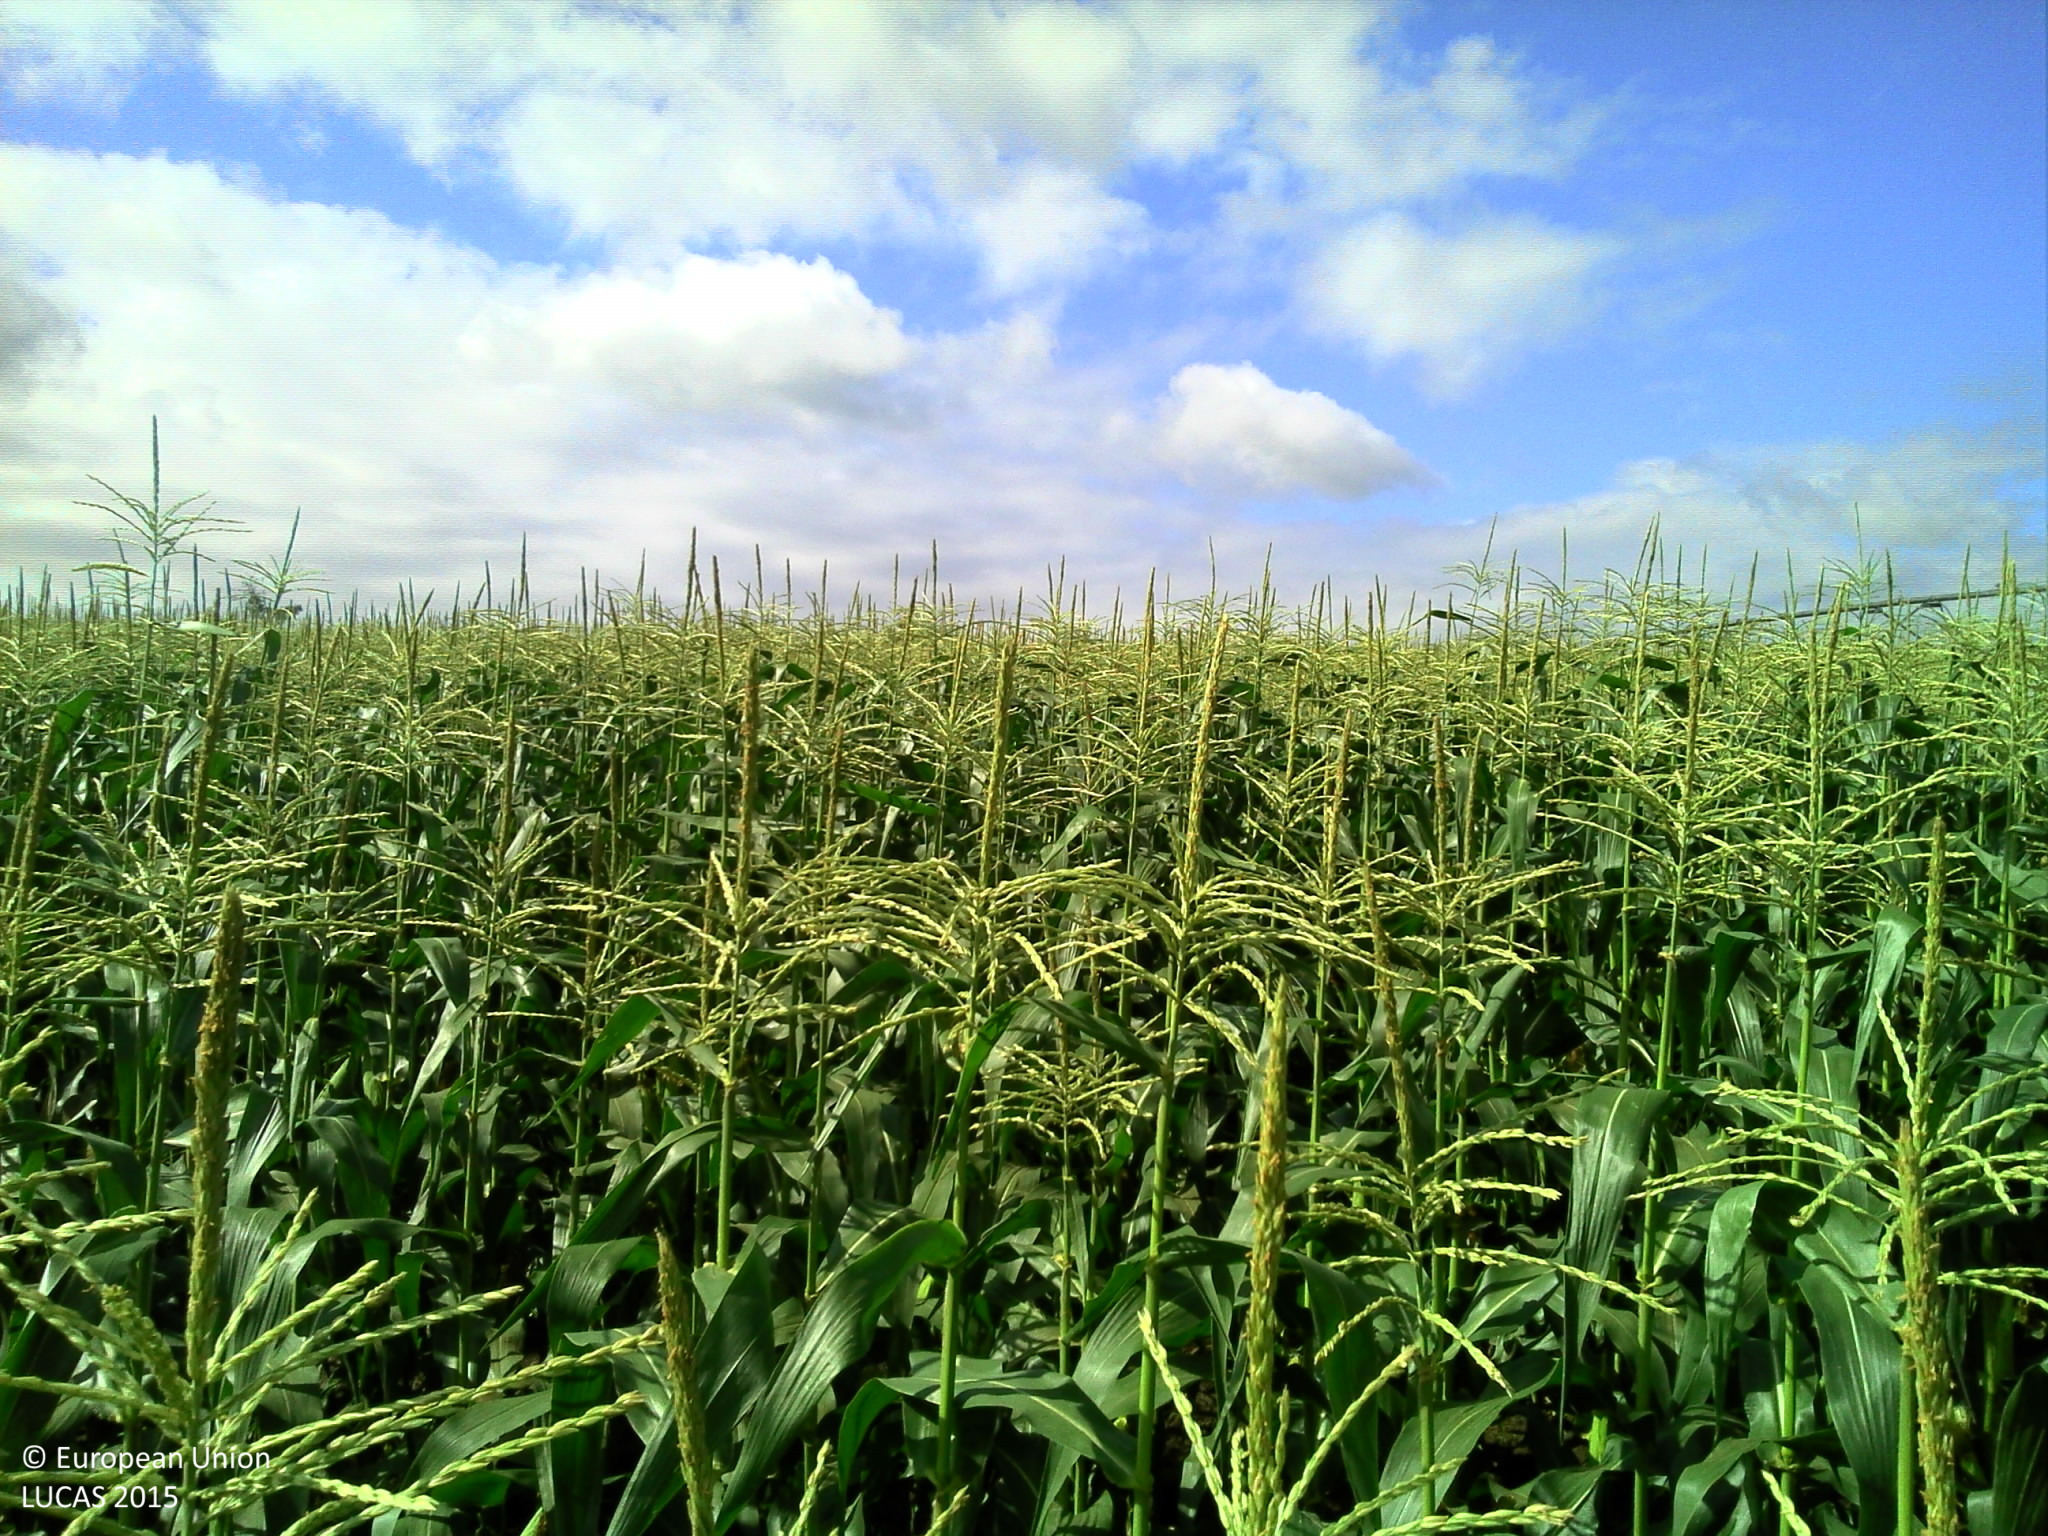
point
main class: Cropland
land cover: Maize
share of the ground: > 75 %
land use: Agriculture (excluding fallow land and kitchen gardens)
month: July
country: FR
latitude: 43.8452
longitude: -0.7483
